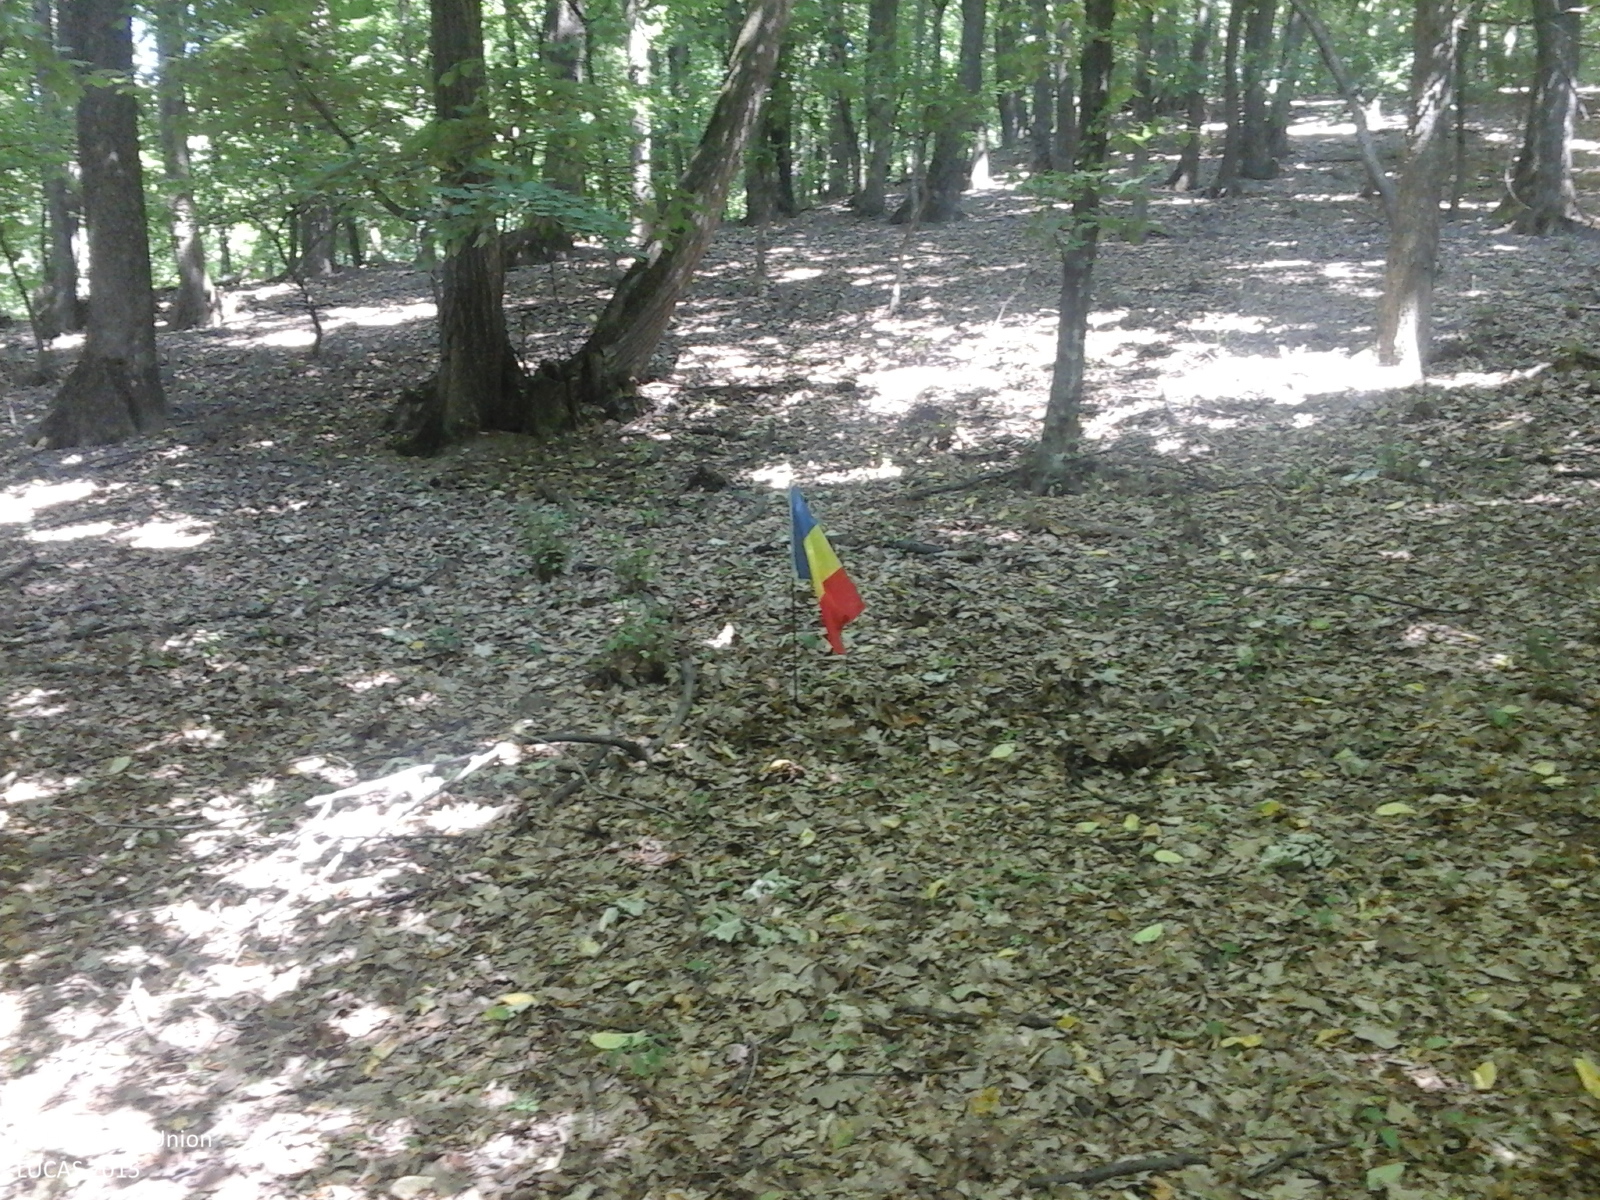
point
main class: Woodland
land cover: Broadleaved woodland
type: beech forest
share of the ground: > 75 %
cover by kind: broadleaved forest trees 100 %
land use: Forestry
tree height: > 5 m
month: June
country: RO
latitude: 46.8485
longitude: 27.0298
